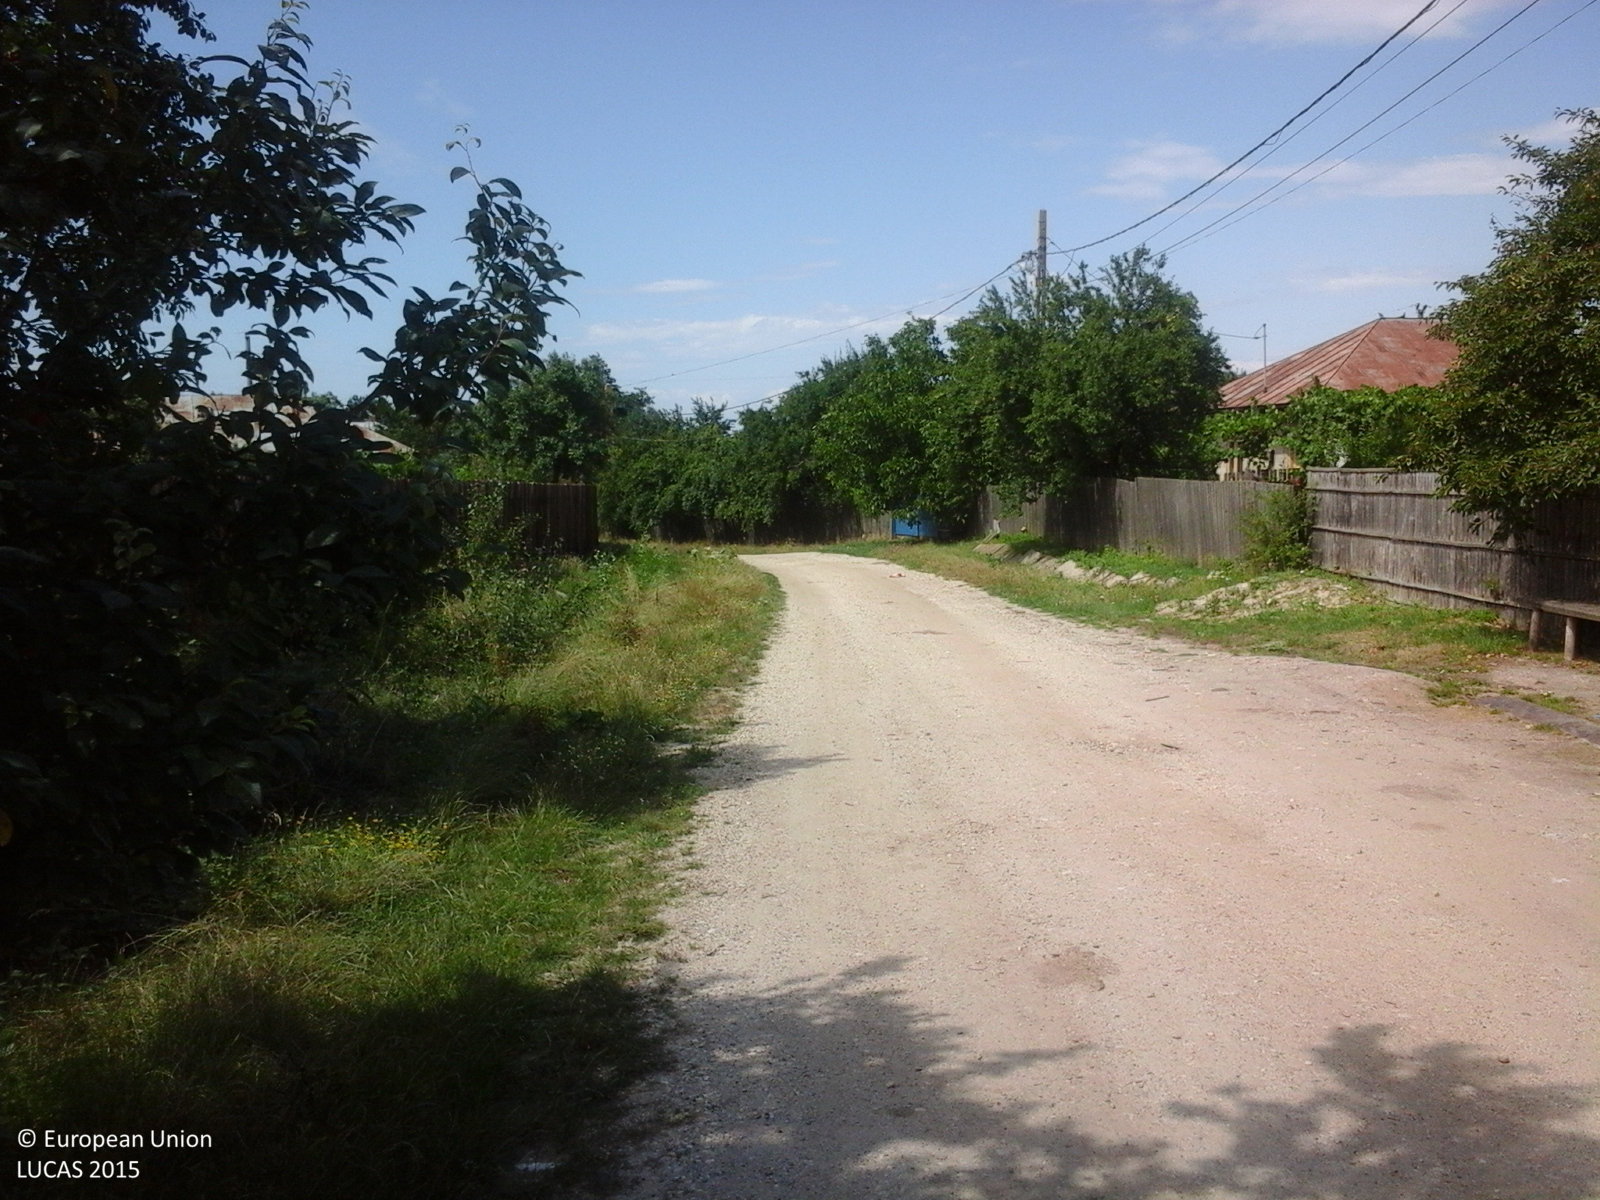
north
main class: Grassland
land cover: Grassland with sparse tree/shrub cover
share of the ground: > 75 %
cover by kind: herbaceous plants 95 %, broadleaved forest trees 5 %
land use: Residential
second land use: Agriculture (excluding fallow land and kitchen gardens)
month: July
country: RO
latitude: 44.3721
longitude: 25.3603
